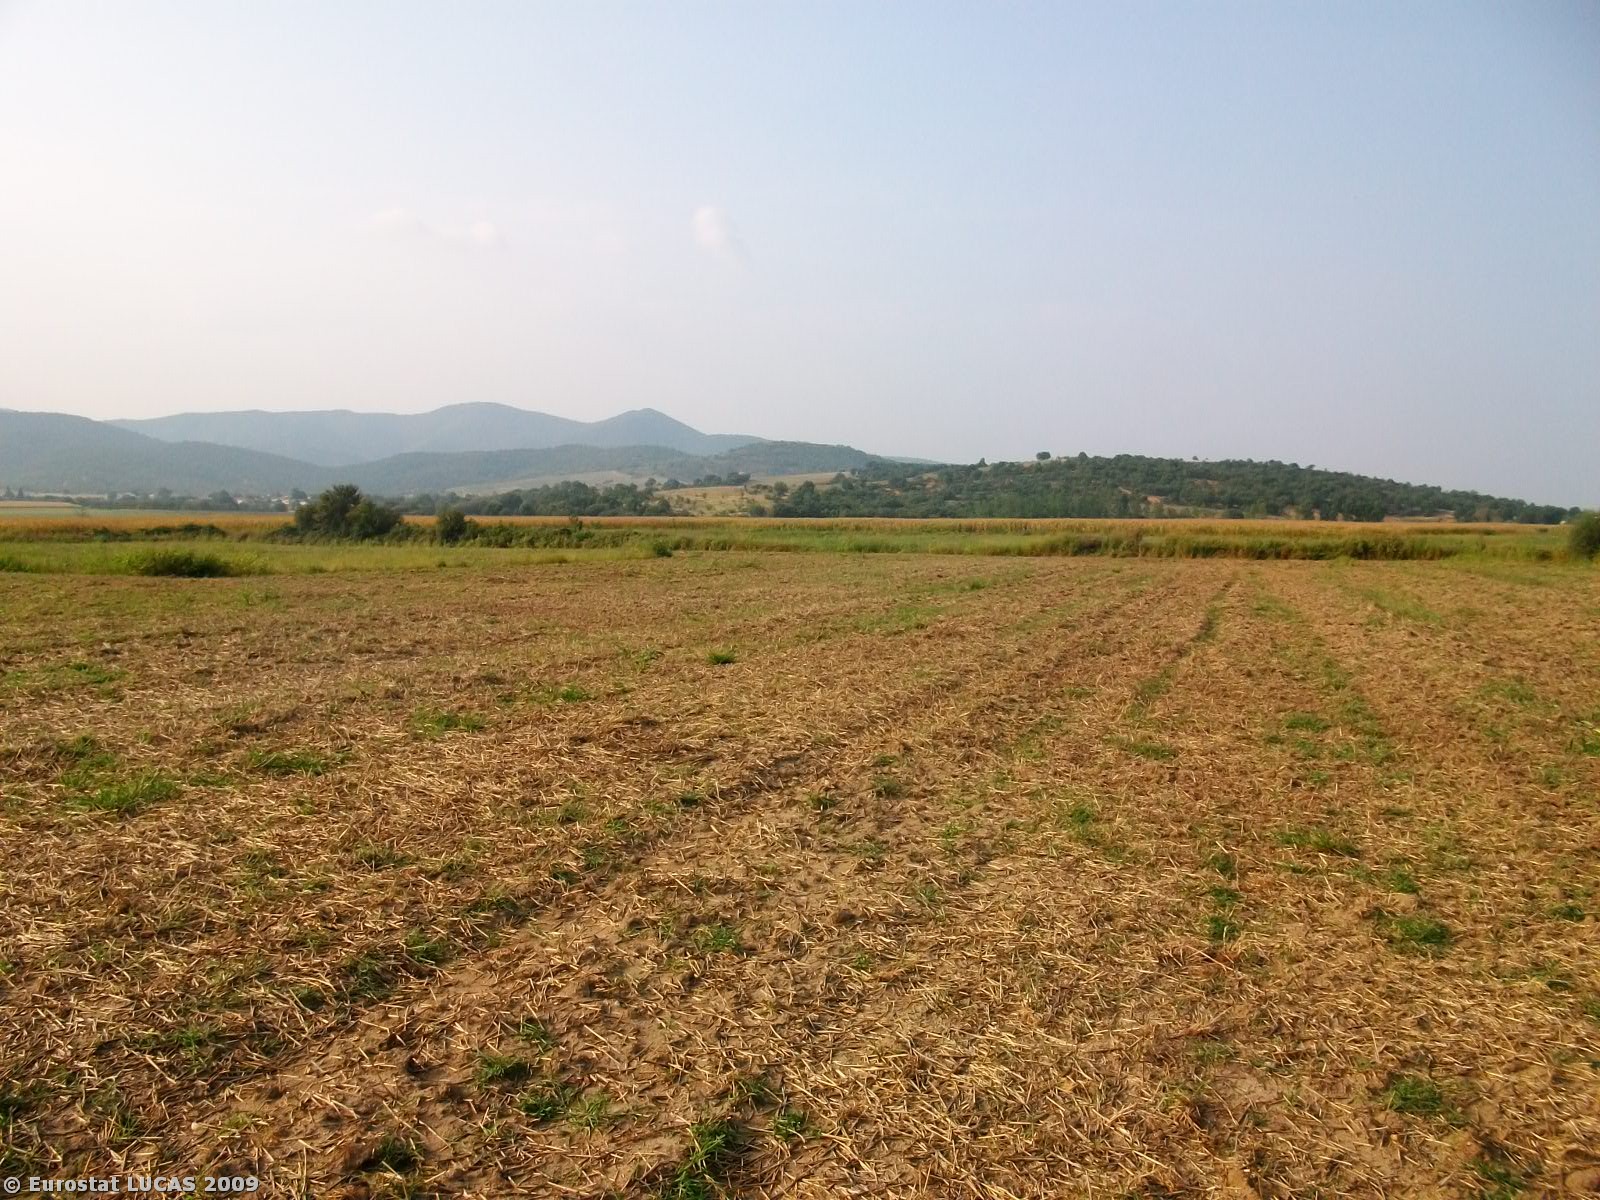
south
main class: Grassland
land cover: Grassland without tree/shrub cover
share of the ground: > 75 %
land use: Agriculture (excluding fallow land and kitchen gardens)
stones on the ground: < 10 %
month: September
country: GR
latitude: 41.2483
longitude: 22.8412
